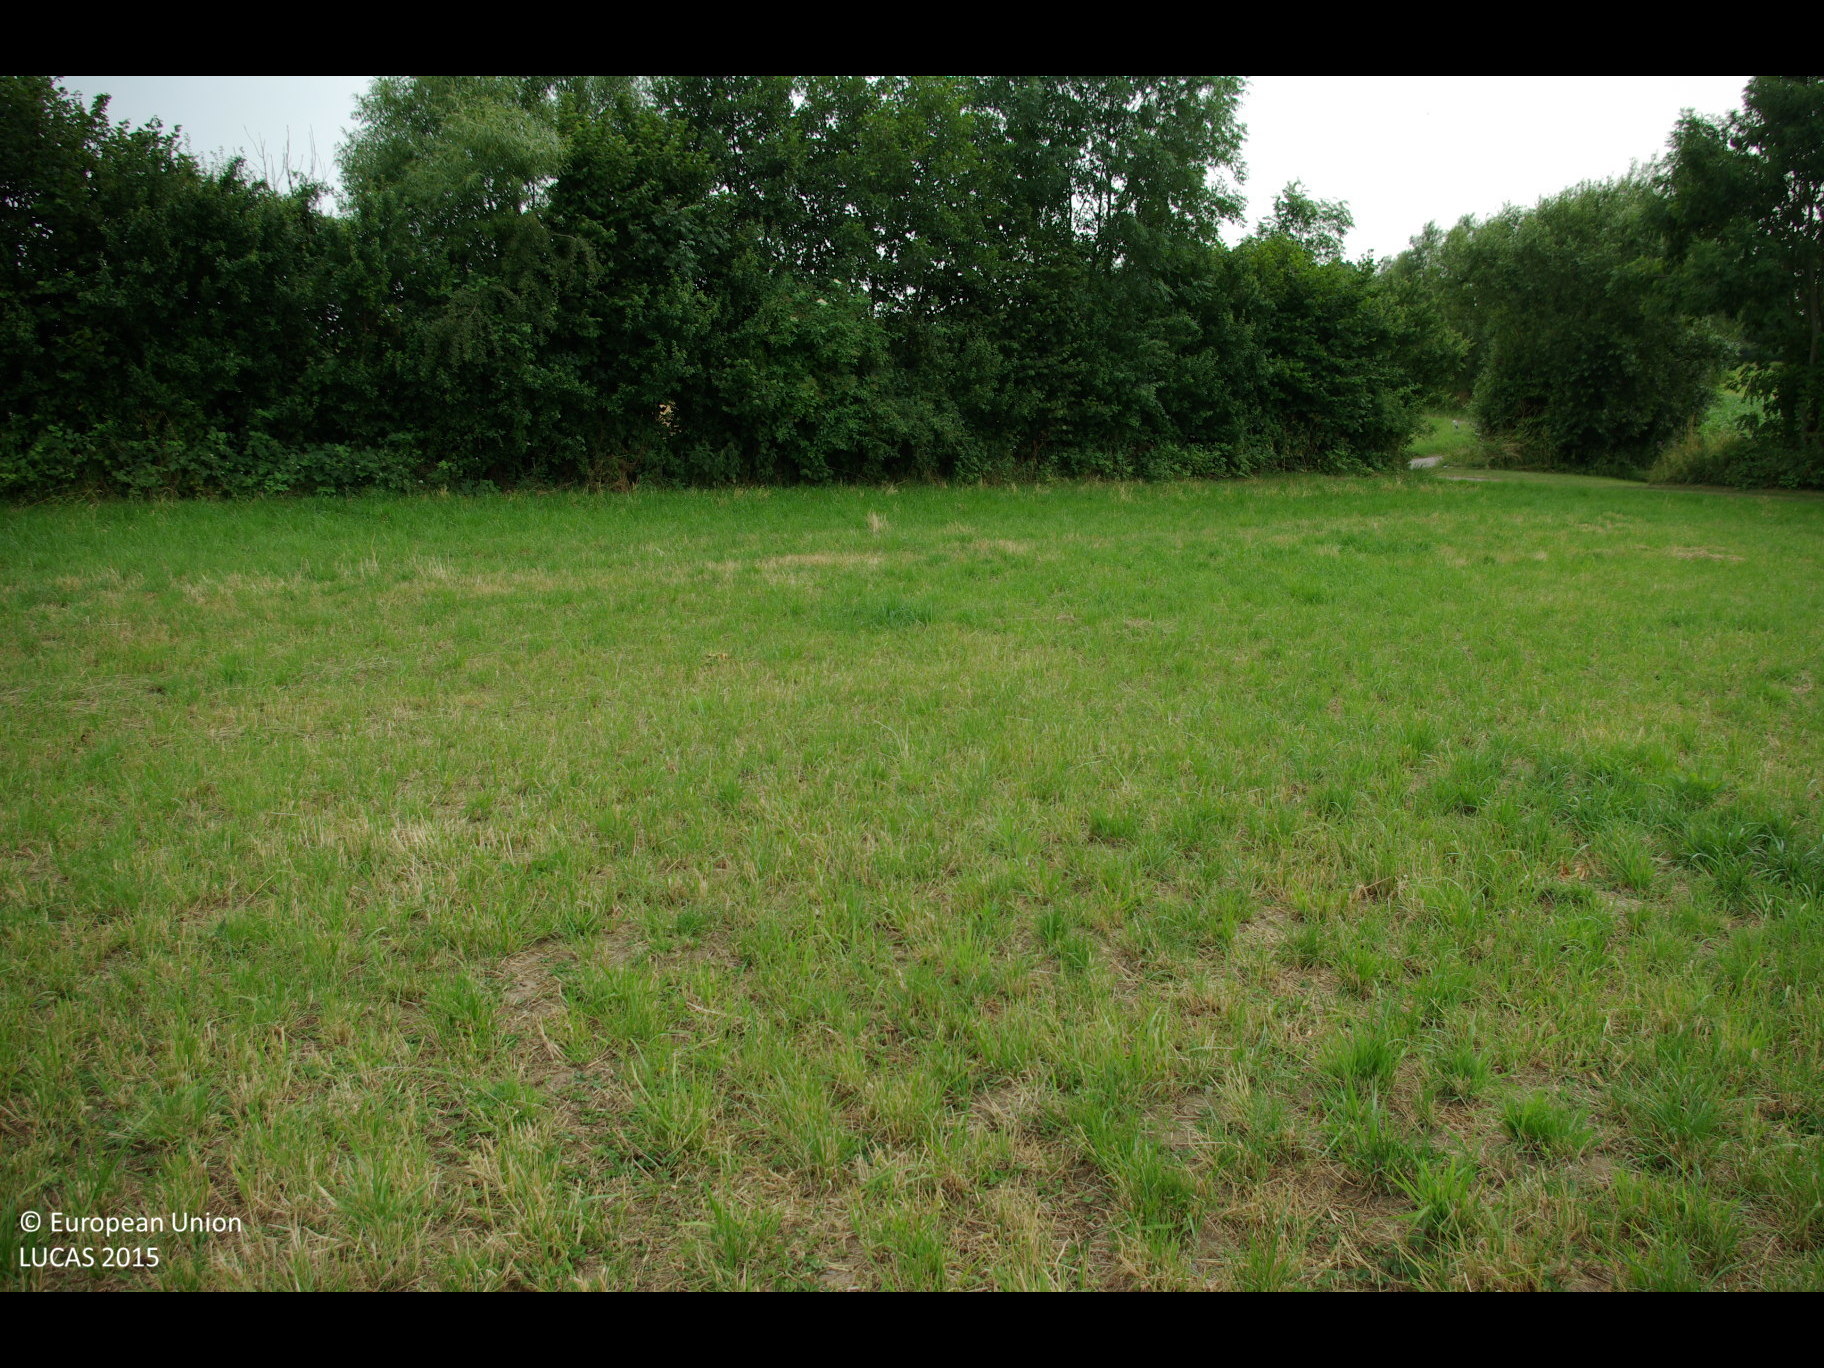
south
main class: Cropland
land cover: Temporary grasslands
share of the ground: > 75 %
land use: Agriculture (excluding fallow land and kitchen gardens)
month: July
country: DE
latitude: 54.6420
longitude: 9.9535
